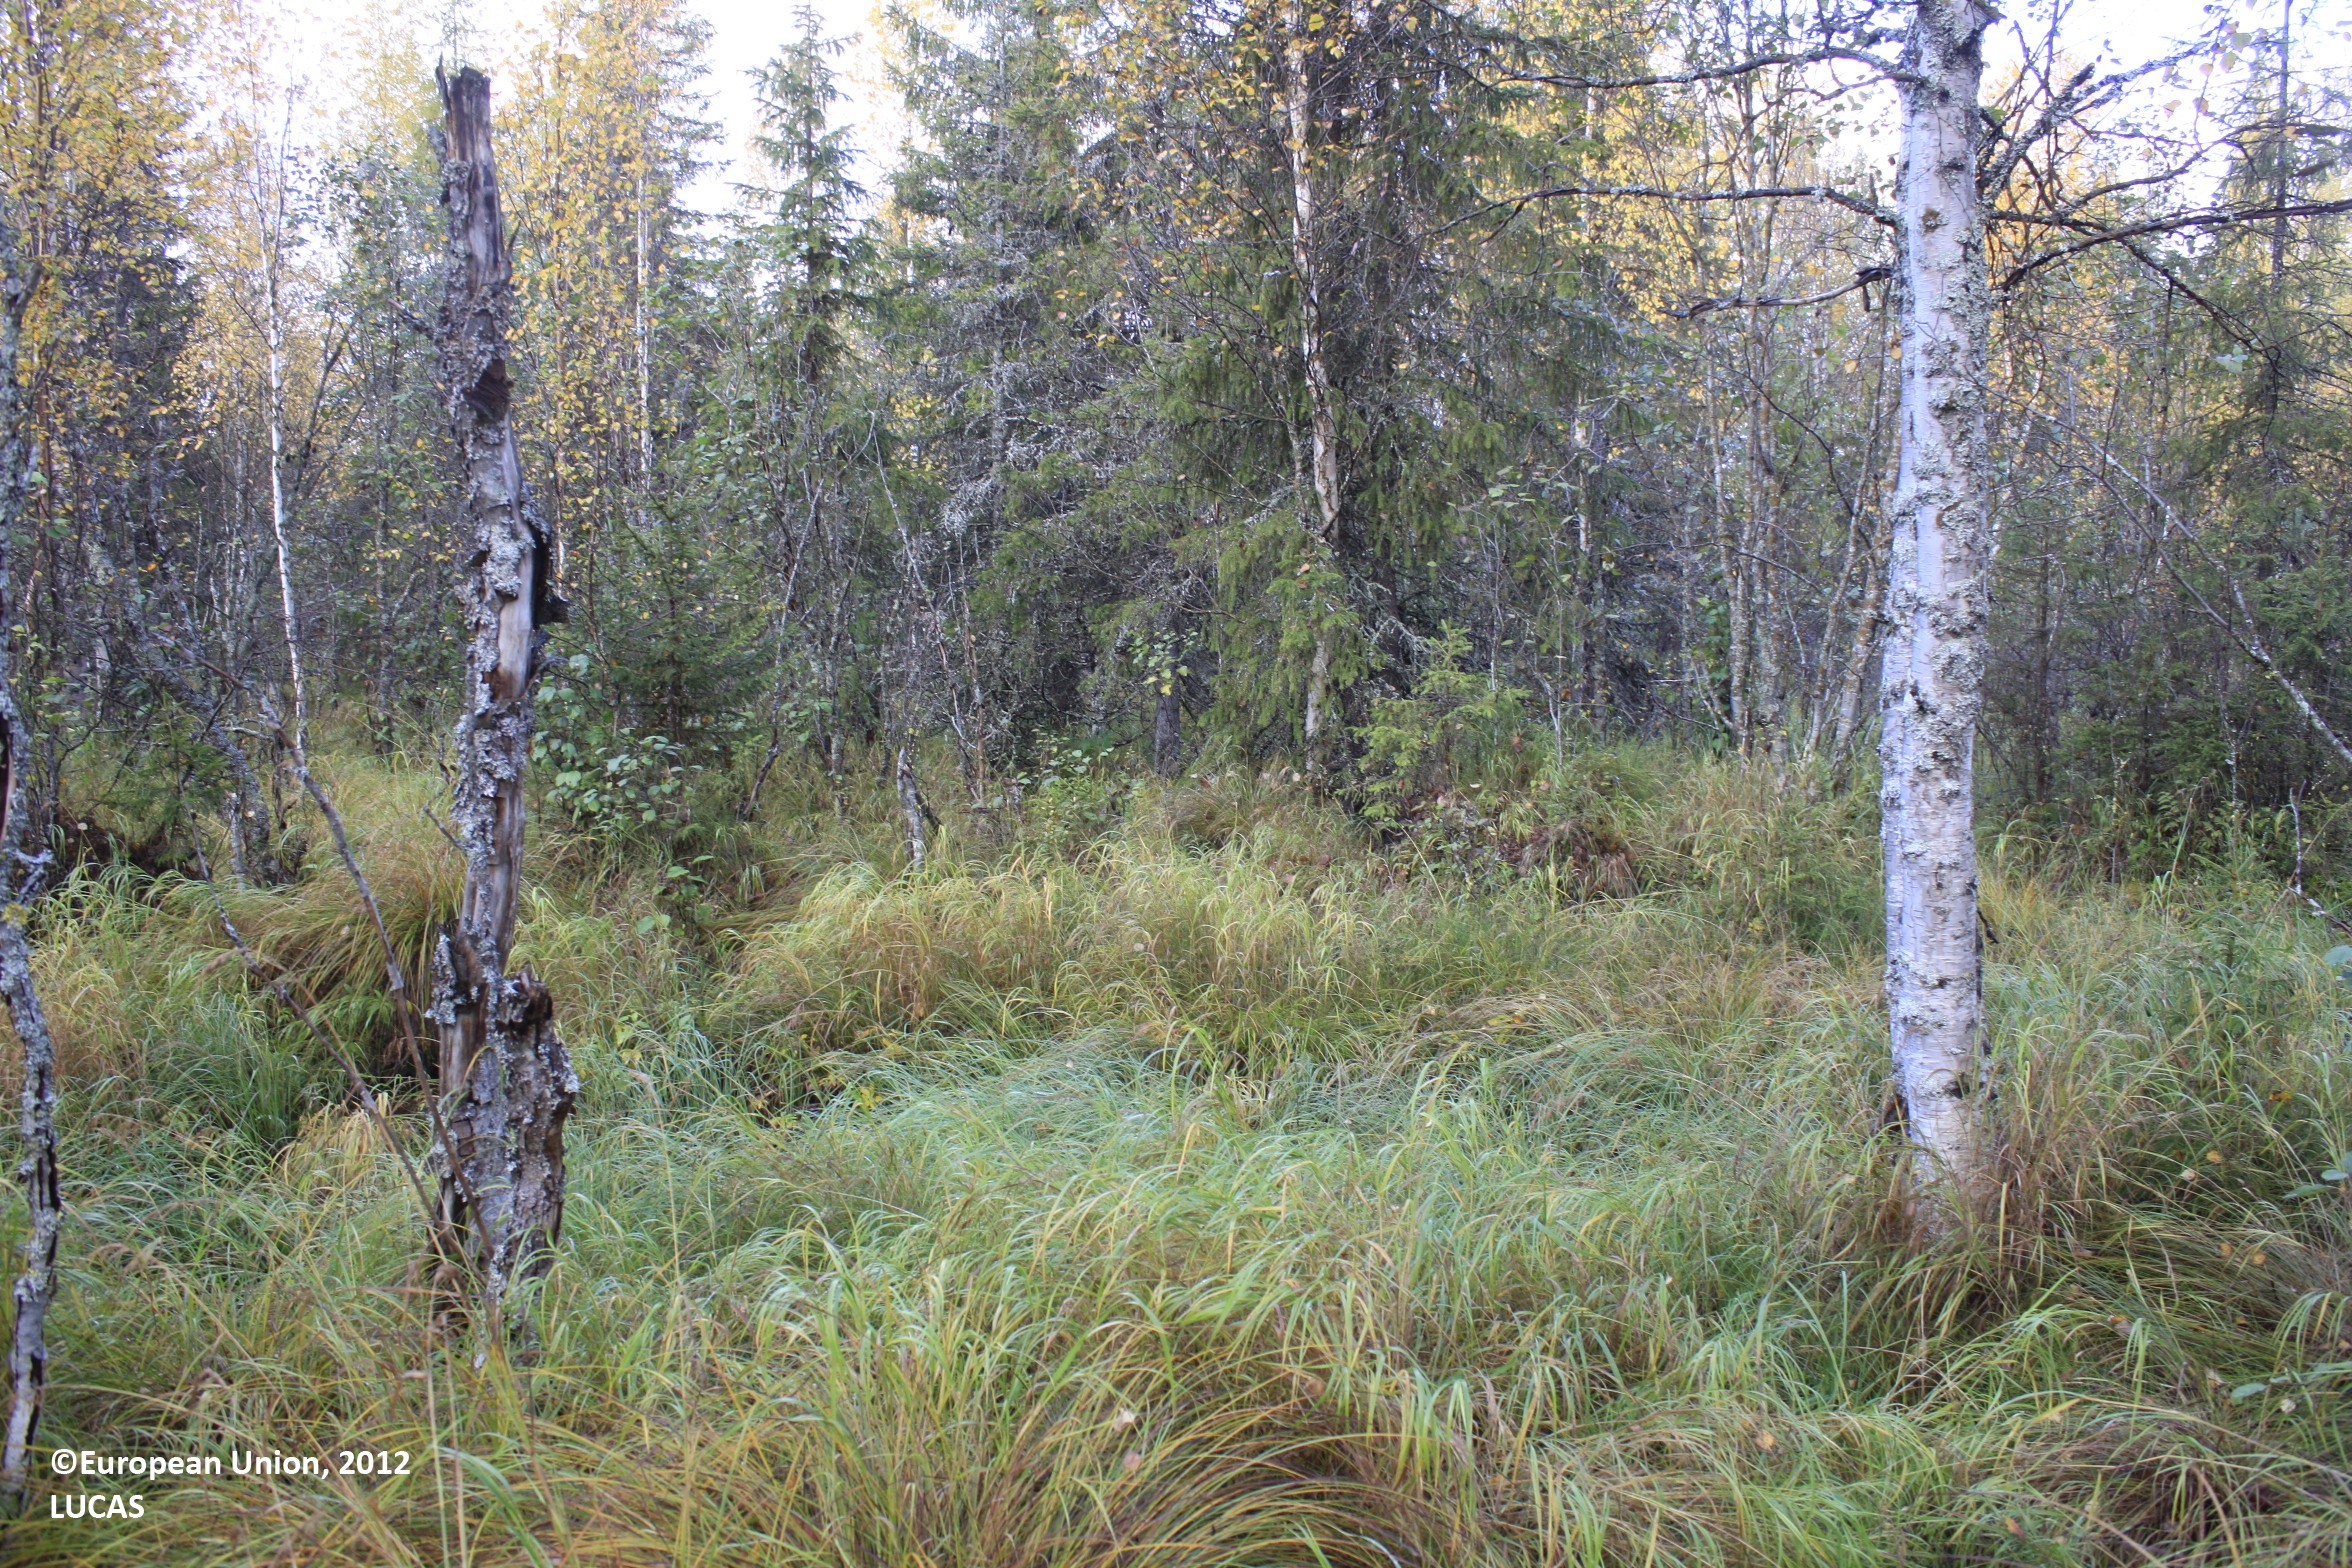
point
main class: Woodland
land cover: Spruce dominated mixed woodland
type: mire and swamp forests
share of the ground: 25 - 50 %
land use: Semi-natural and natural areas not in use
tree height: > 5 m
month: September
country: FI
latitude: 65.5929
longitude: 27.3215
